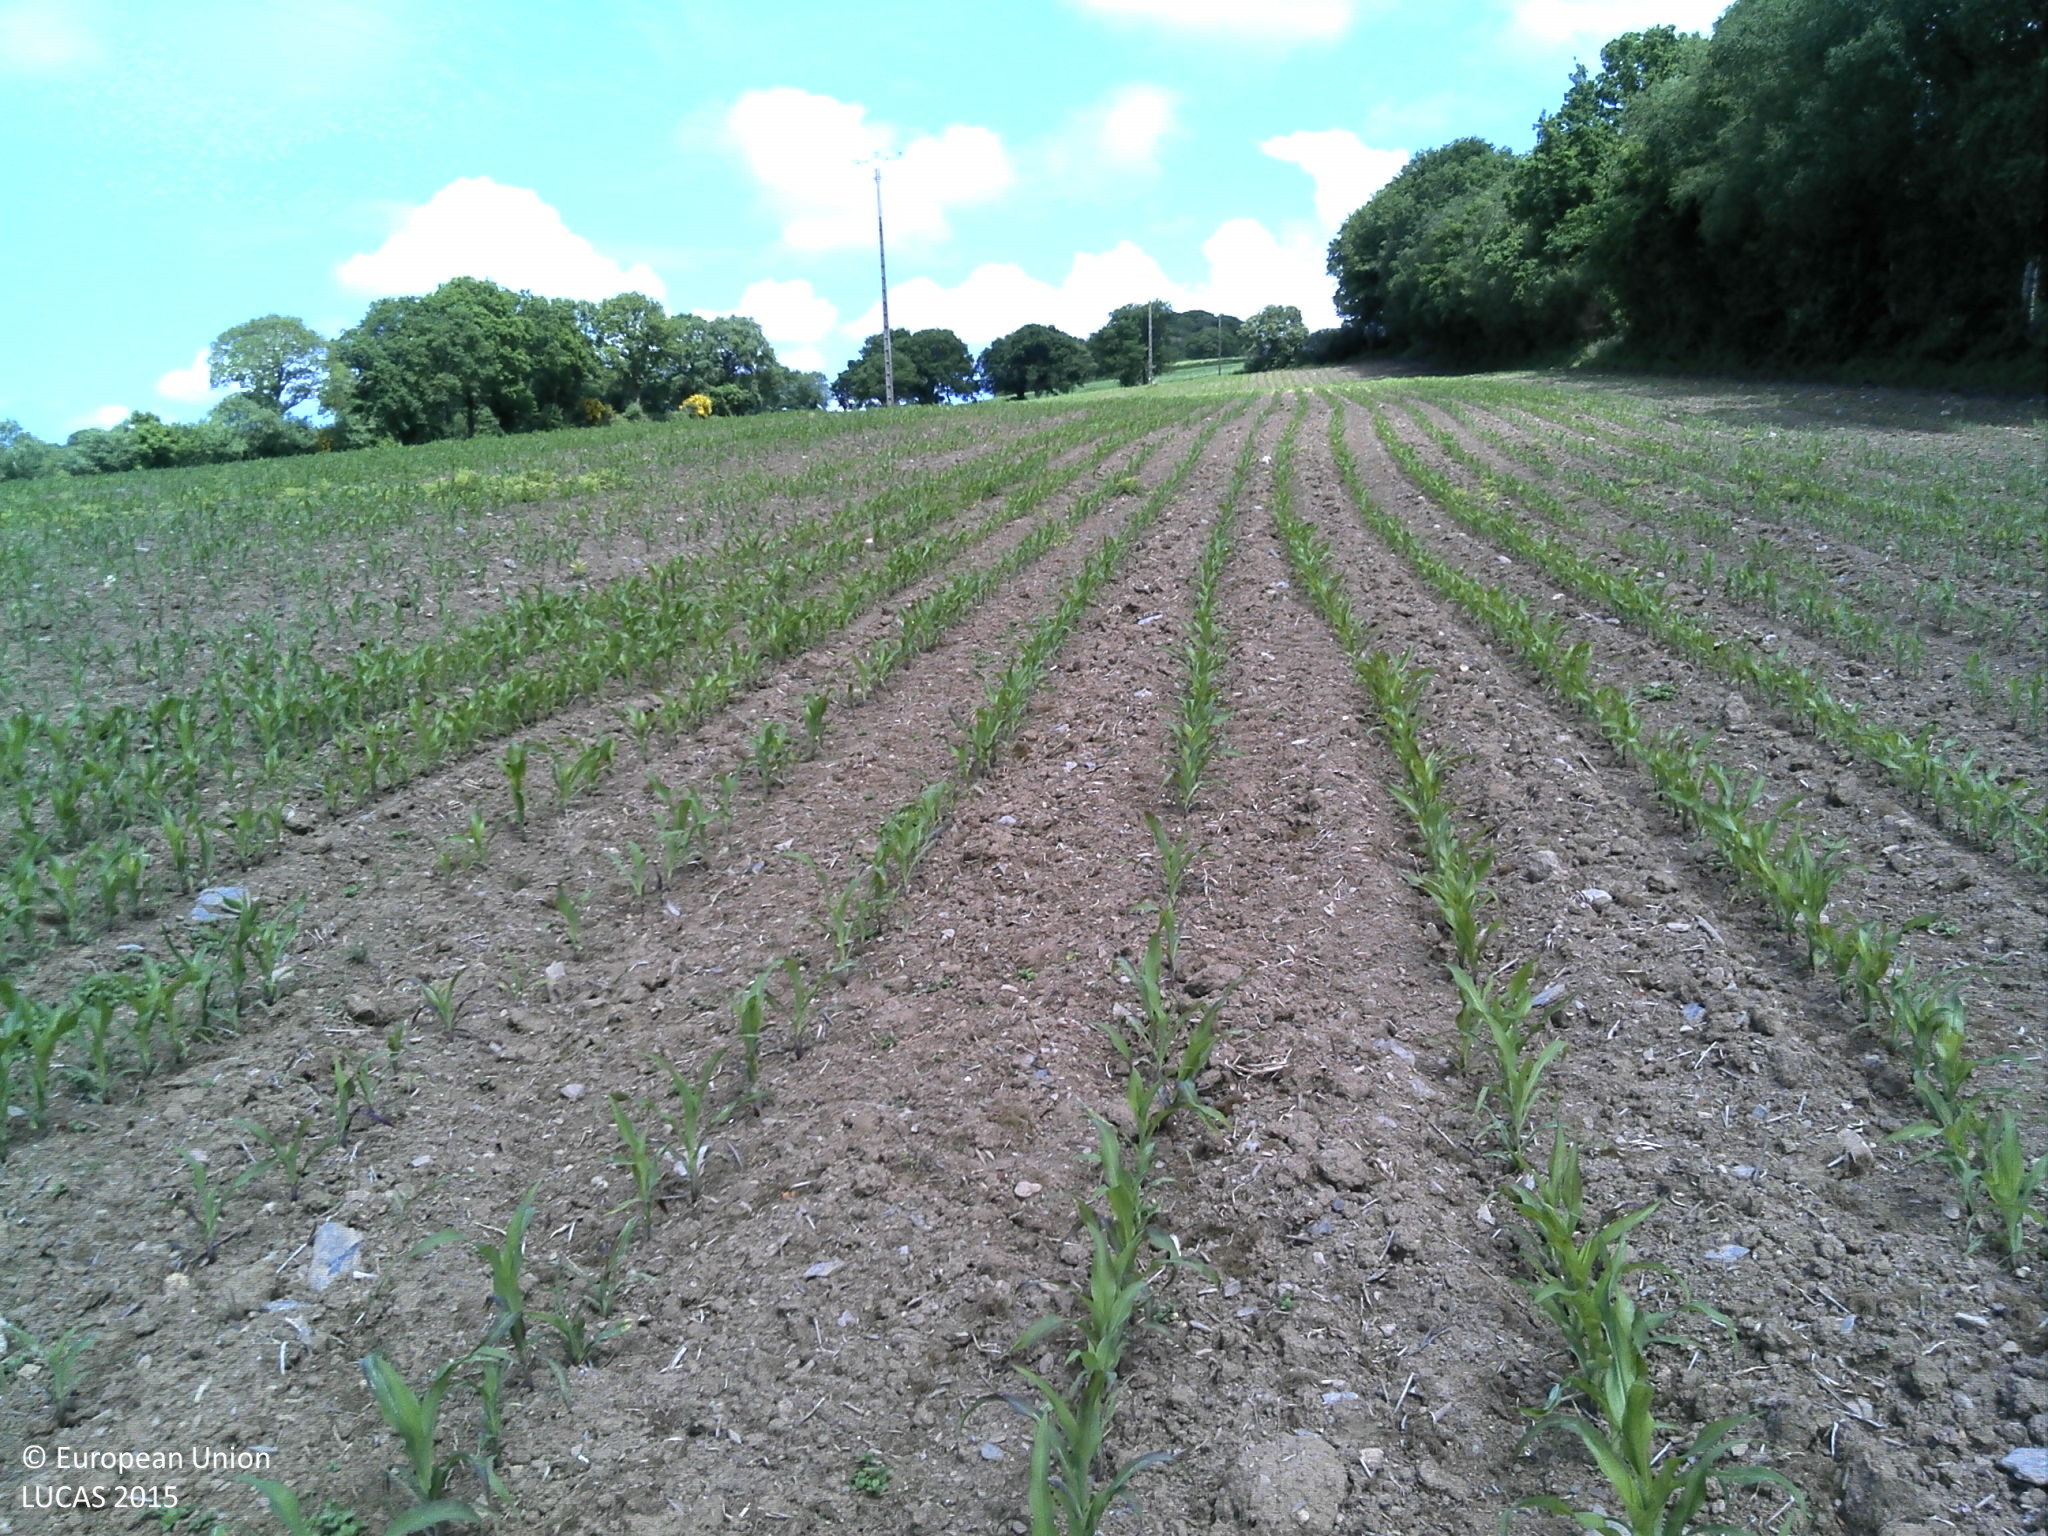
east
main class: Cropland
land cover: Maize
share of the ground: 10 - 25 %
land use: Agriculture (excluding fallow land and kitchen gardens)
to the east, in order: Maize; Broadleaved woodland; Tracks; Broadleaved woodland; Barley
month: June
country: FR
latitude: 48.4372
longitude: -3.7216
